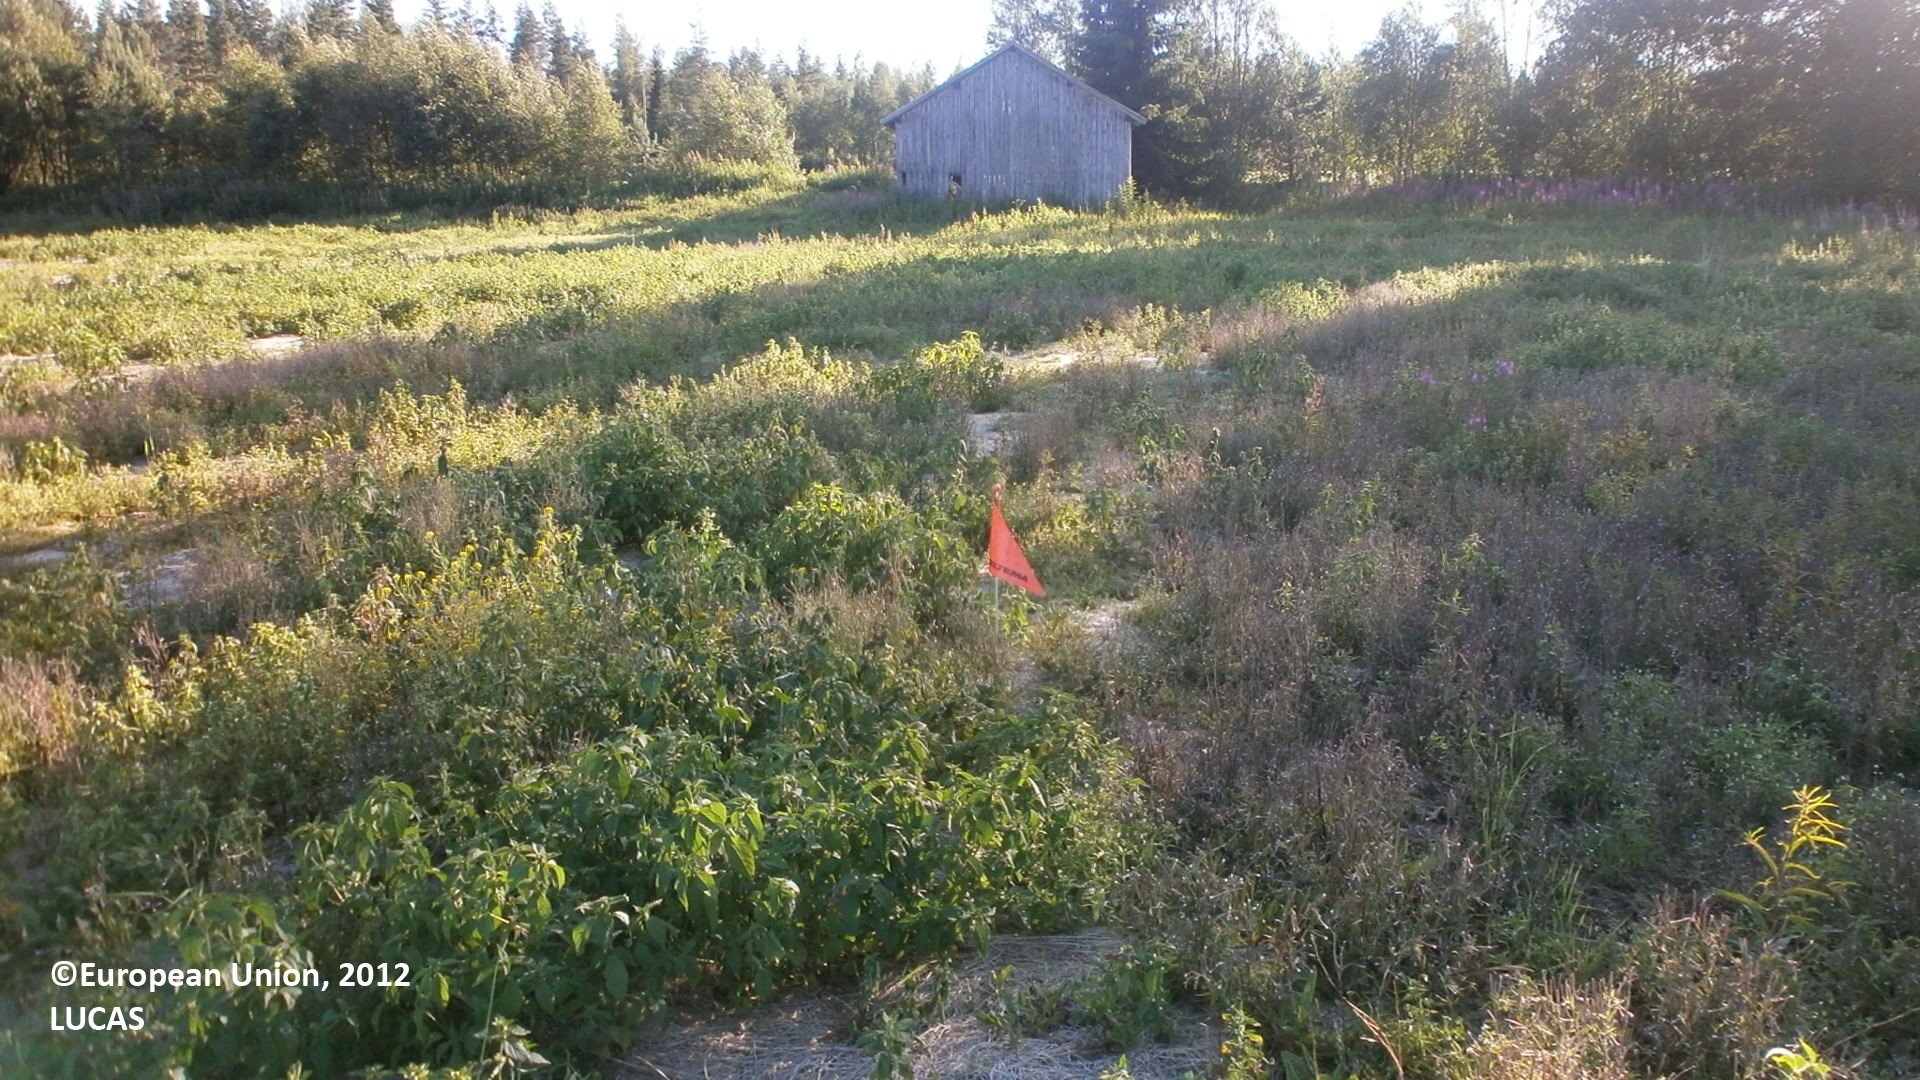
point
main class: Grassland
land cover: Grassland without tree/shrub cover
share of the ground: > 75 %
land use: Fallow land
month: July
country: FI
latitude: 64.0272
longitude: 24.0440
